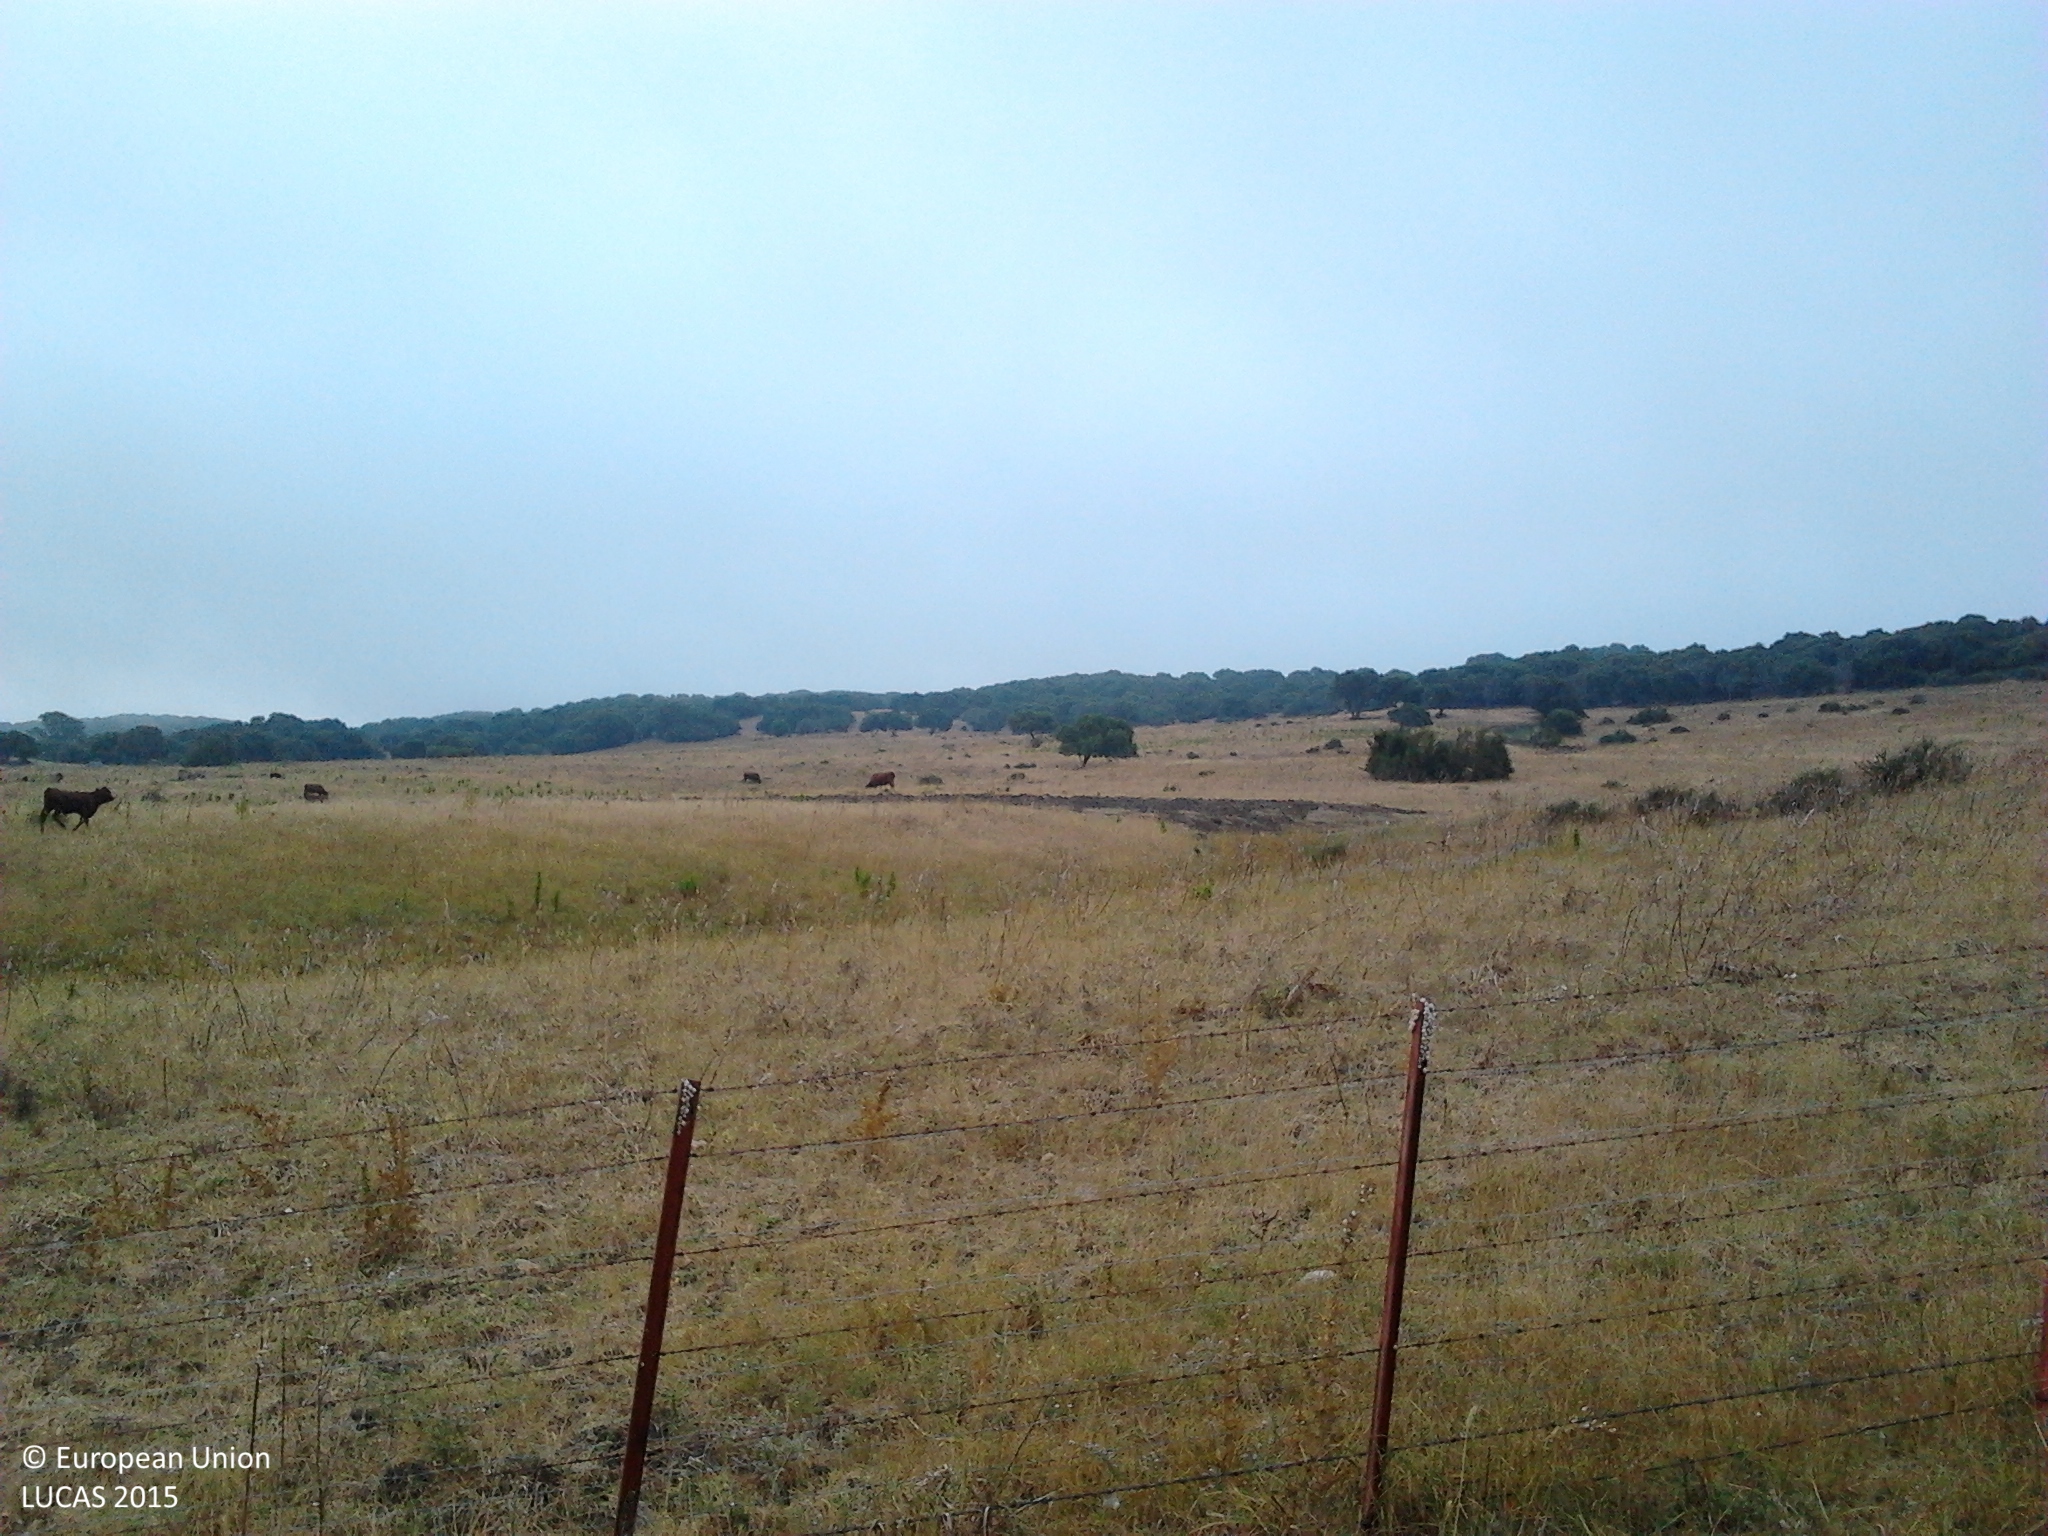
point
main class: Grassland
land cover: Grassland without tree/shrub cover
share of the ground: > 75 %
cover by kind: herbaceous plants 100 %
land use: Agriculture (excluding fallow land and kitchen gardens)
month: July
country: ES
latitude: 36.3561
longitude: -5.8363
